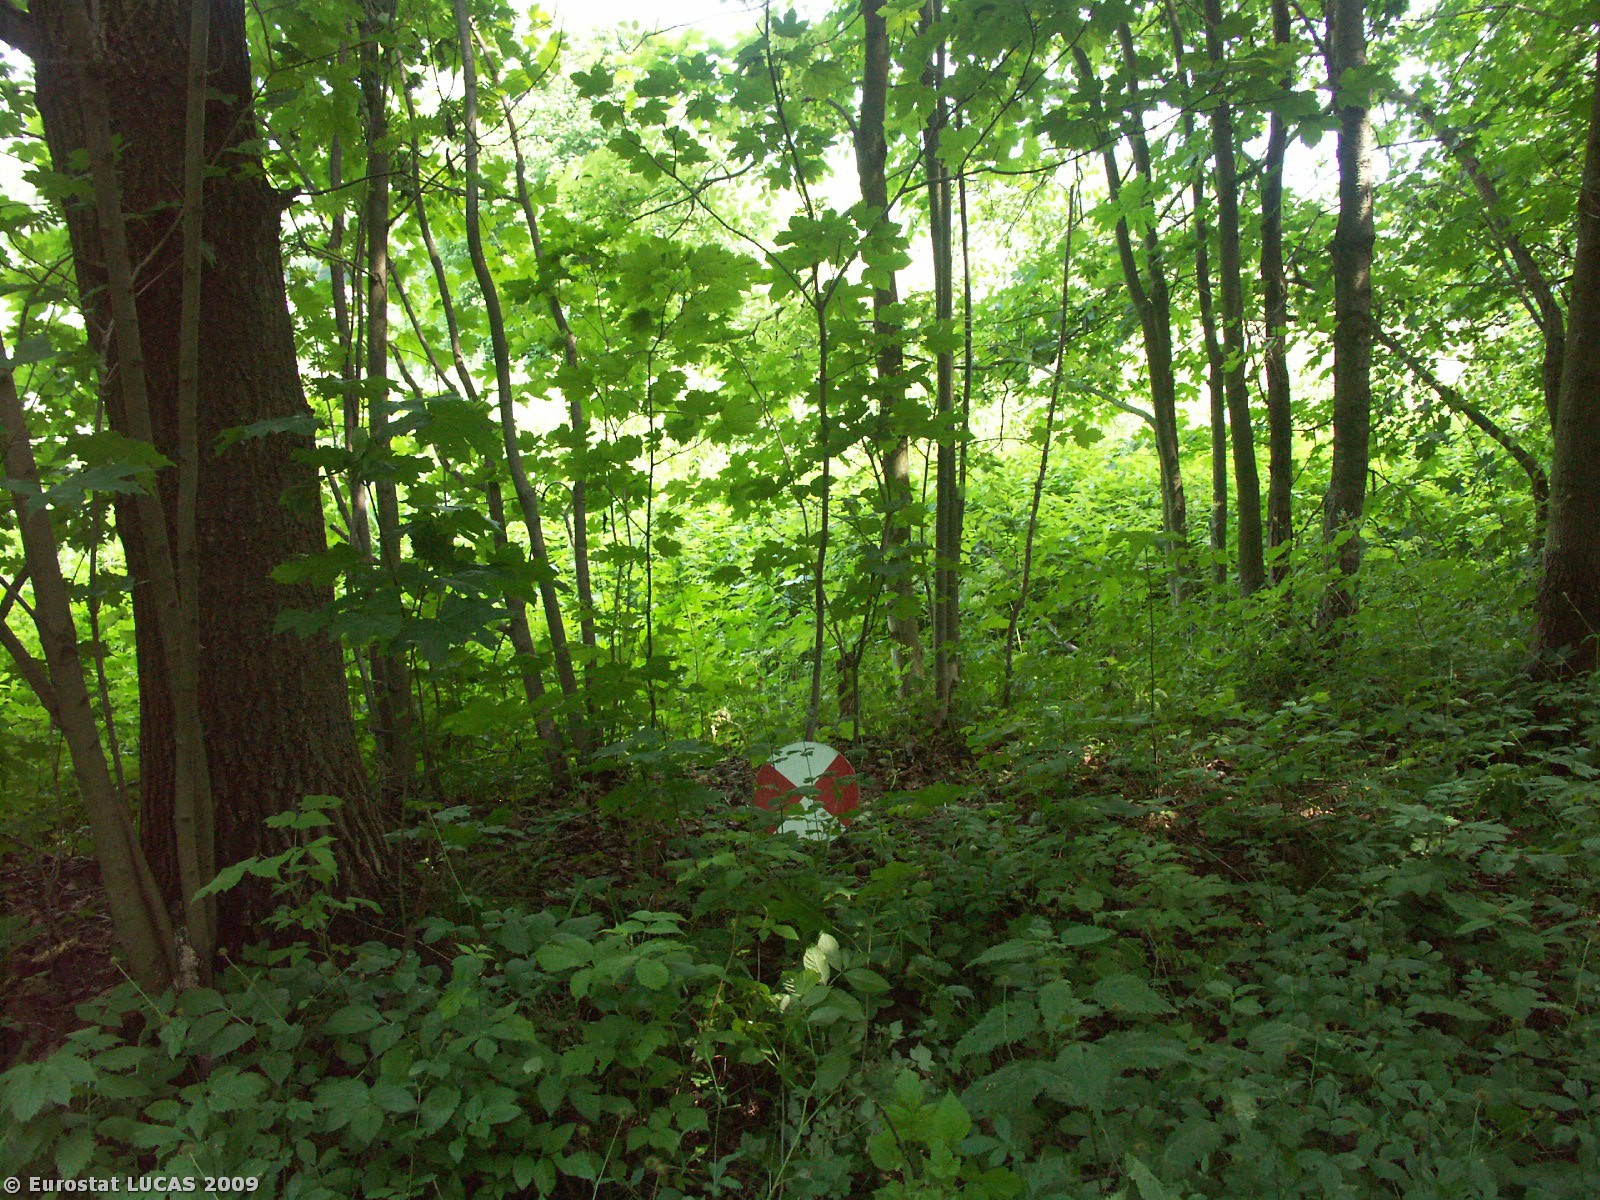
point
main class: Woodland
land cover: Broadleaved woodland
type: floodplain forest
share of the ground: > 75 %
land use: Forestry
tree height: > 5 m
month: June
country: CZ
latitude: 50.0968
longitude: 16.6764
